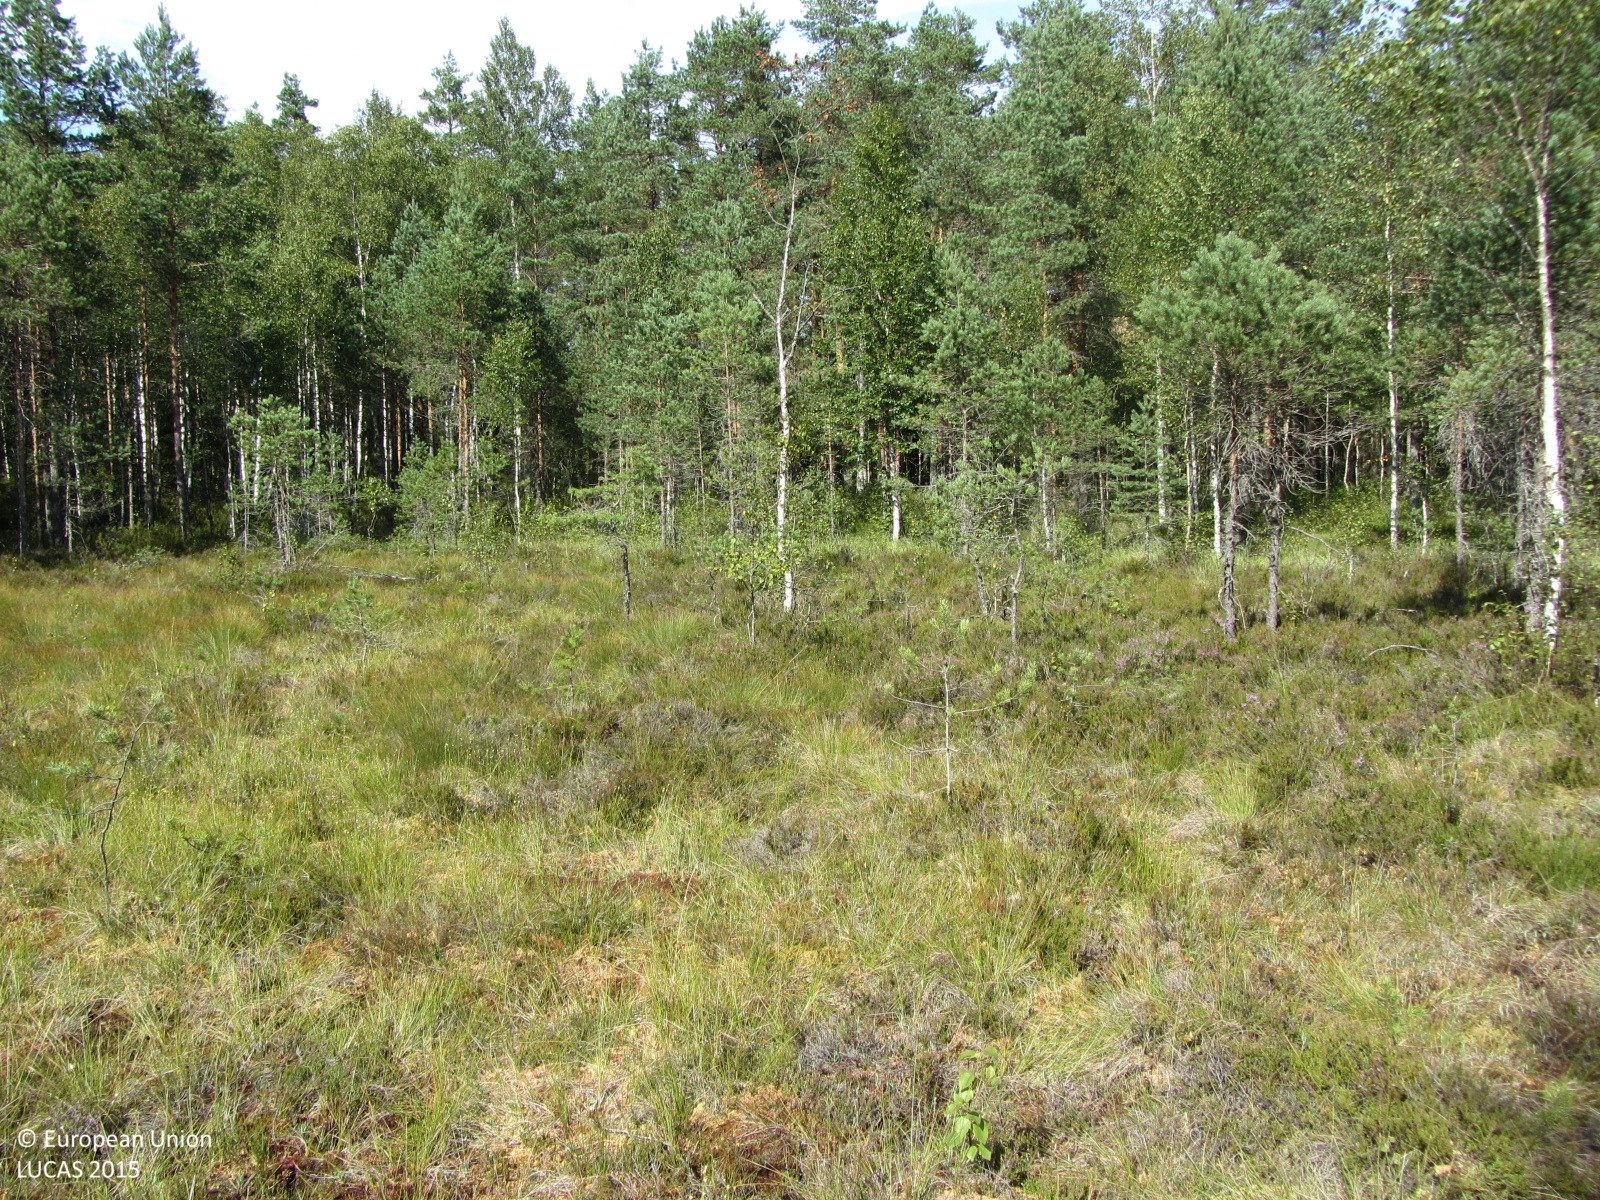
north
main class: Woodland
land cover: Pine dominated mixed woodland
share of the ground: 10 - 25 %
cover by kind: shrubs 60 %, herbaceous plants 15 %, coniferous forest trees 10 %, lichens and mosses 10 %, broadleaved forest trees 5 %
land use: Semi-natural and natural areas not in use
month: August
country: FI
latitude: 60.4515
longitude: 23.4102
